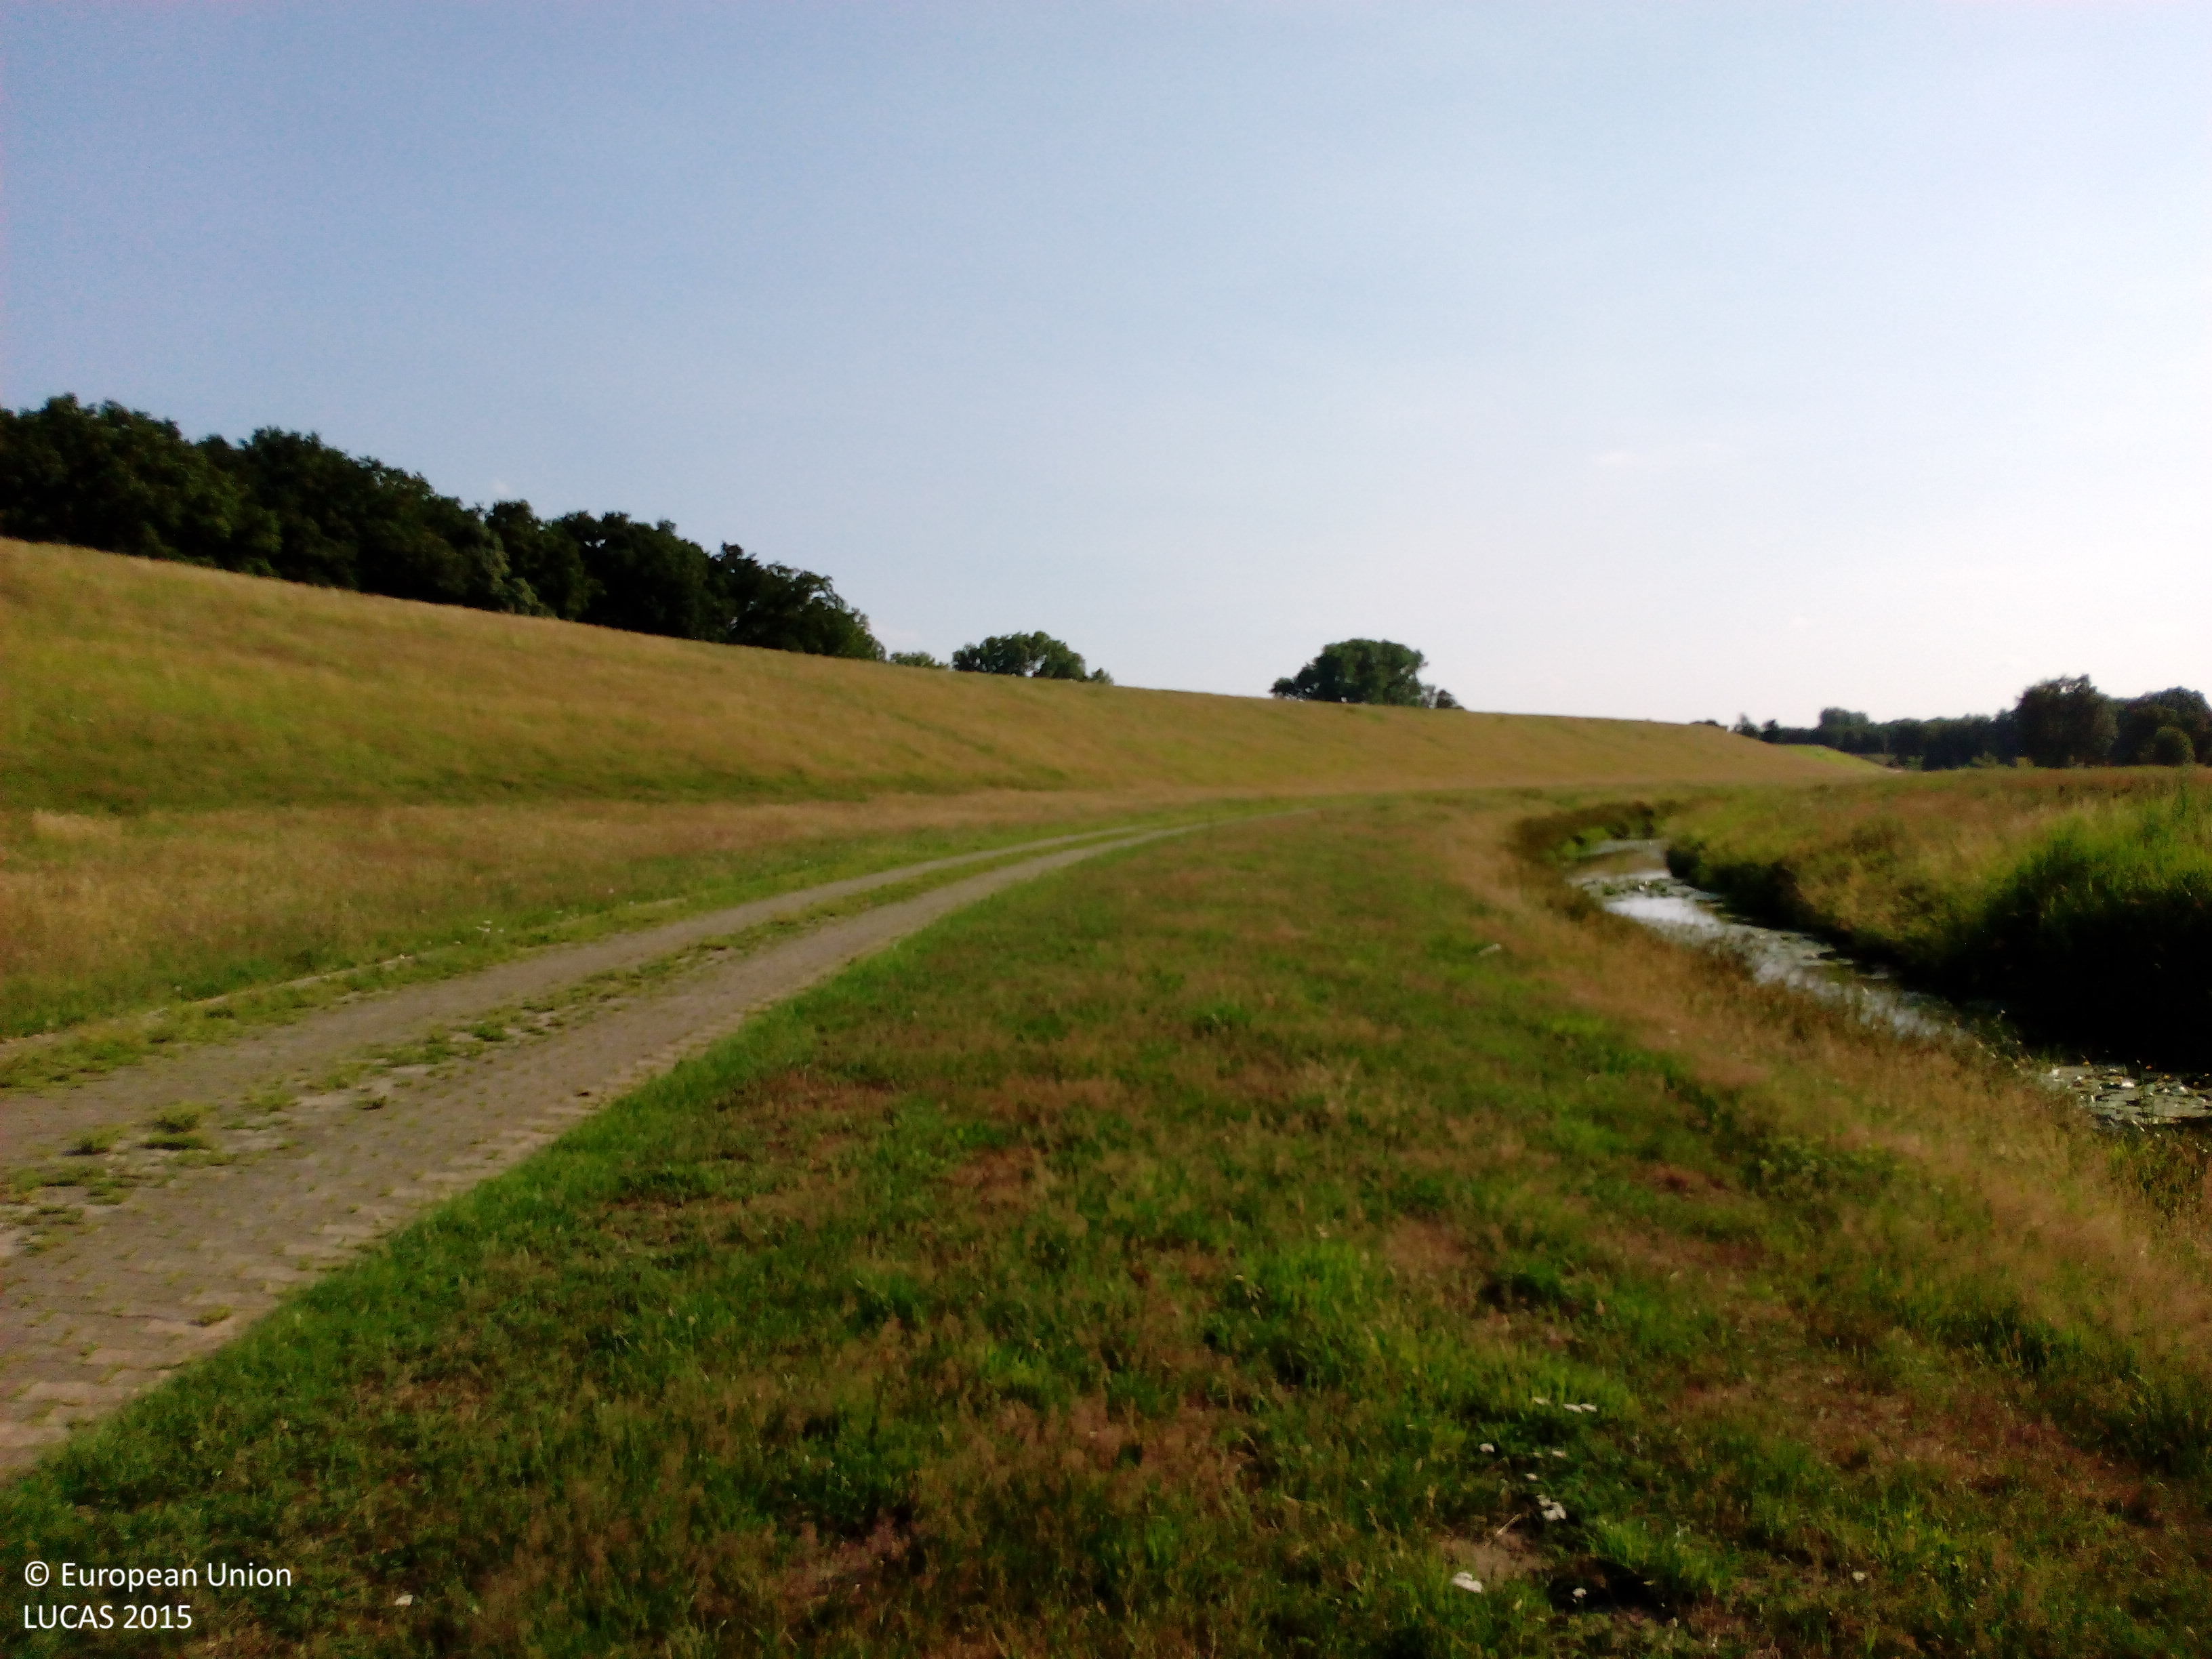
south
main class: Grassland
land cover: Spontaneously vegetated surfaces
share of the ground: > 75 %
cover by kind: herbaceous plants 100 %
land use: Agriculture (excluding fallow land and kitchen gardens)
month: July
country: DE
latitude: 52.5042
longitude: 7.9822
